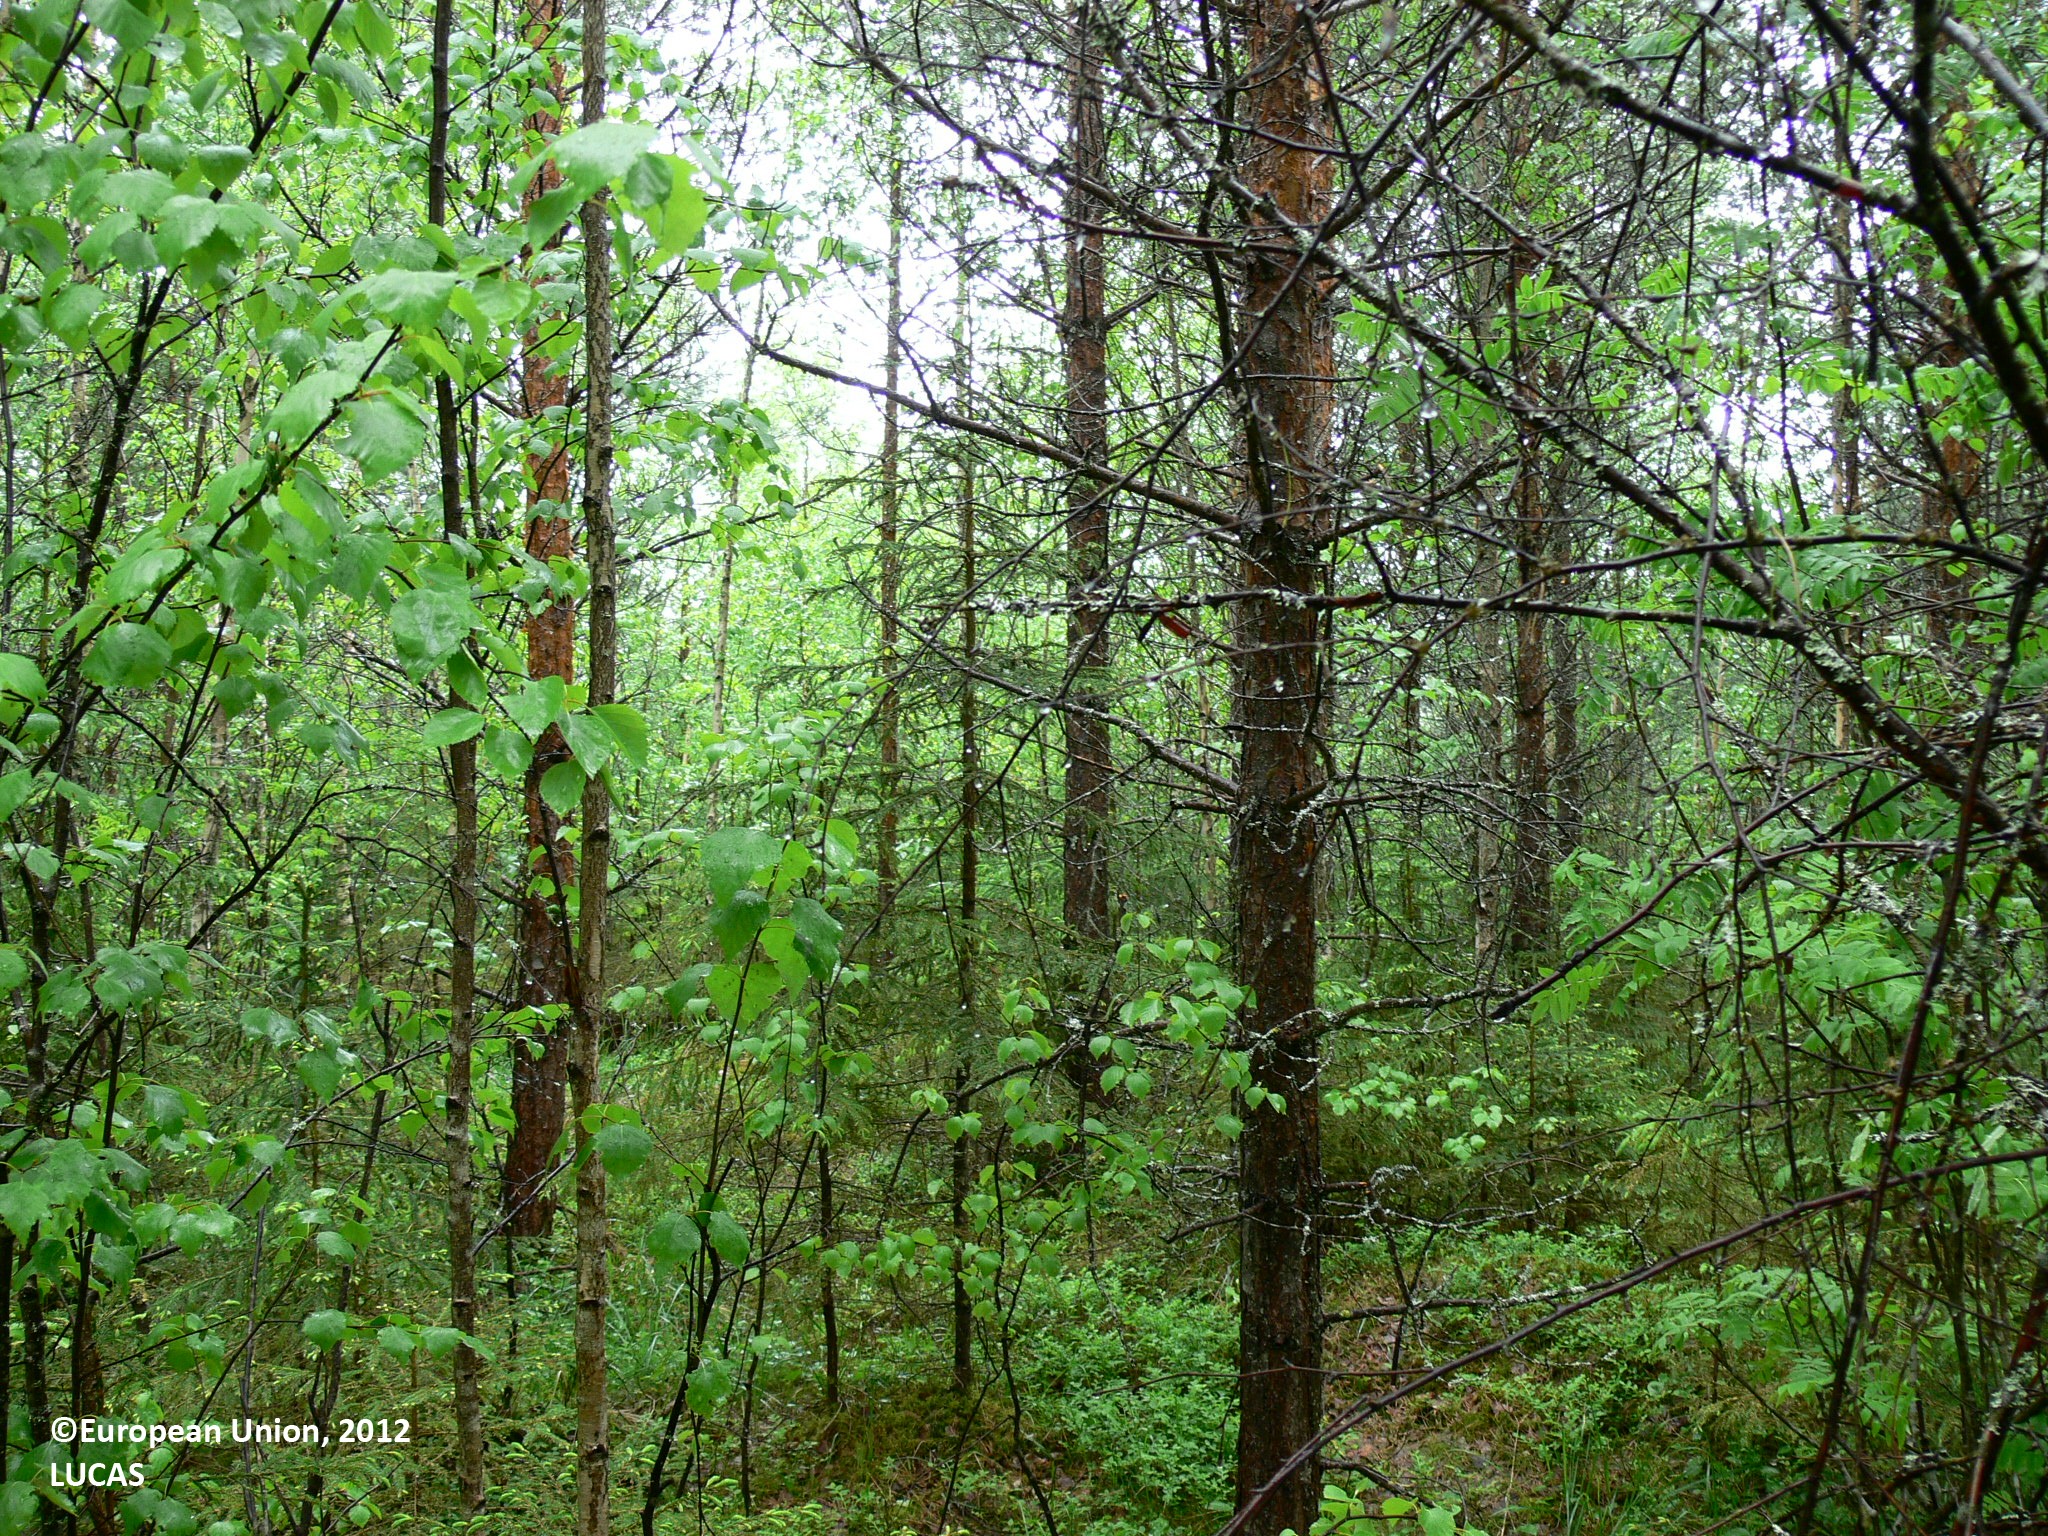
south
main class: Woodland
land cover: Other mixed woodland
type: boreal forest
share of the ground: > 75 %
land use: Forestry
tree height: > 5 m
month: June
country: FI
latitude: 62.5284
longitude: 30.3476
